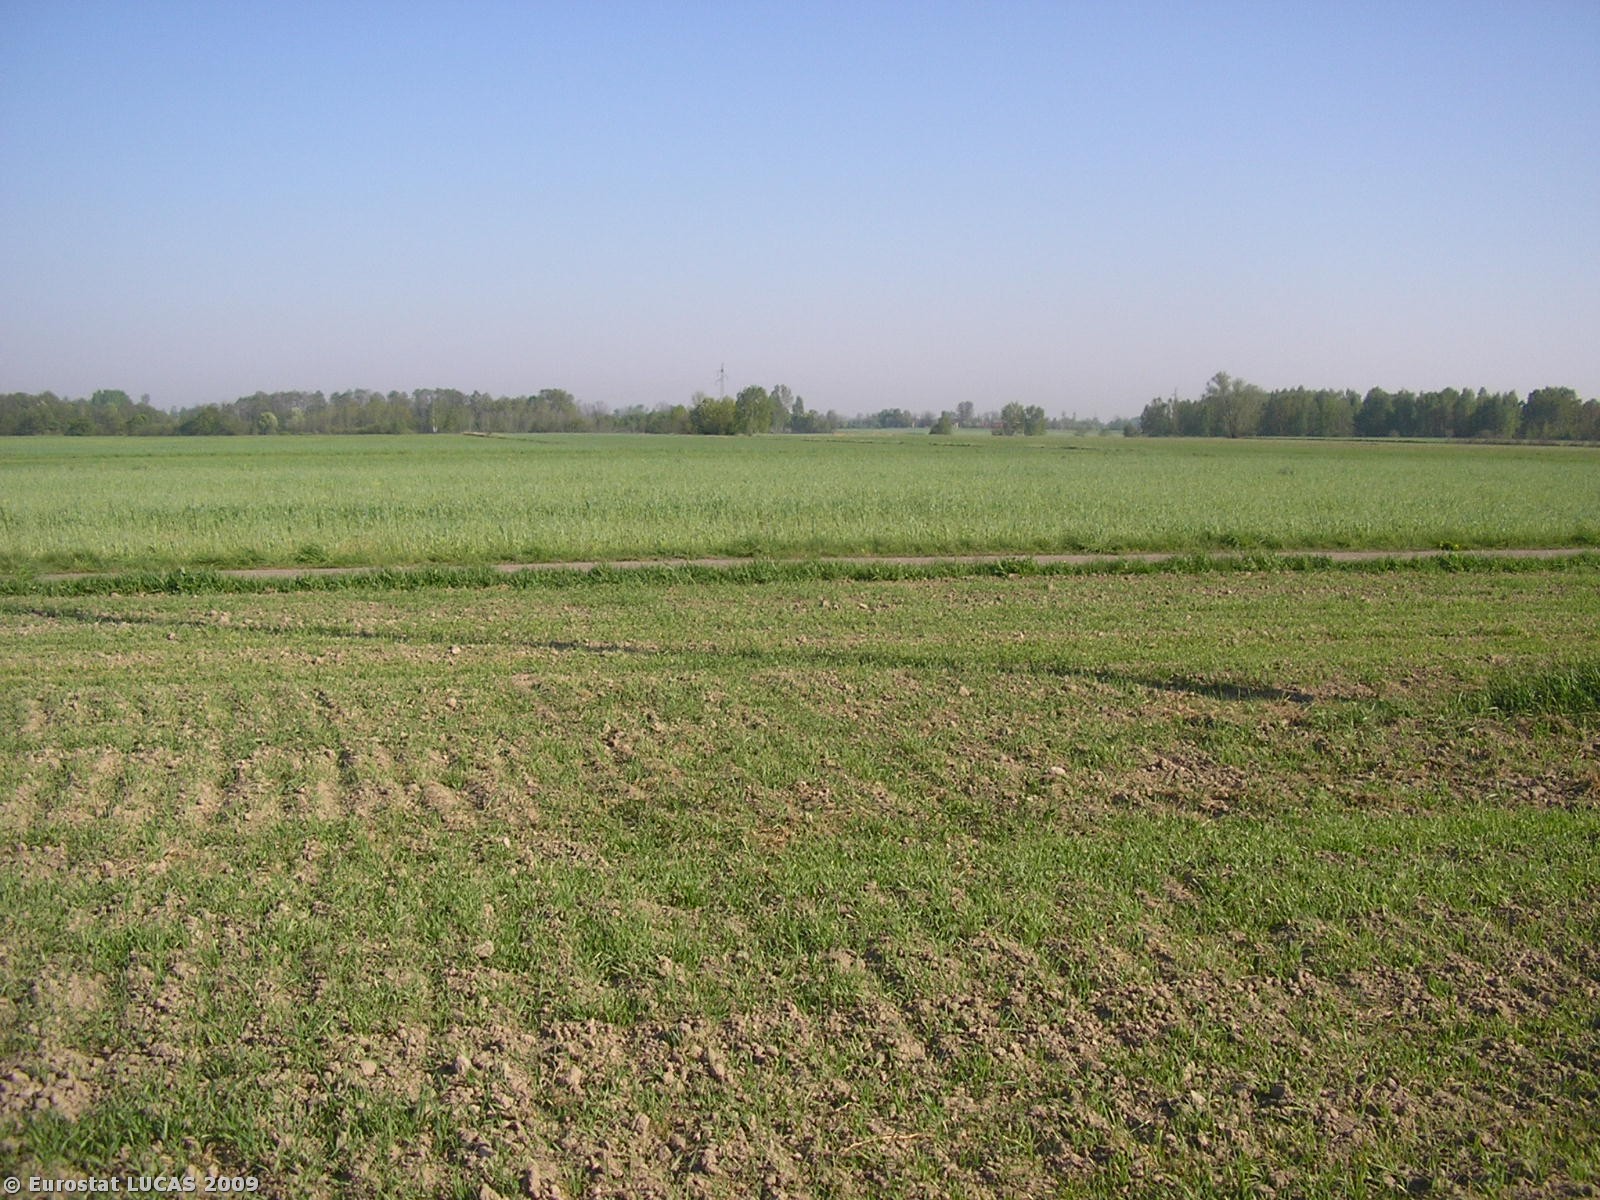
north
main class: Cropland
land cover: Mixed cereals for fodder
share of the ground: < 10 %
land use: Agriculture (excluding fallow land and kitchen gardens)
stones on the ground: < 10 %
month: April
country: PL
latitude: 52.2109
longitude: 20.1765
